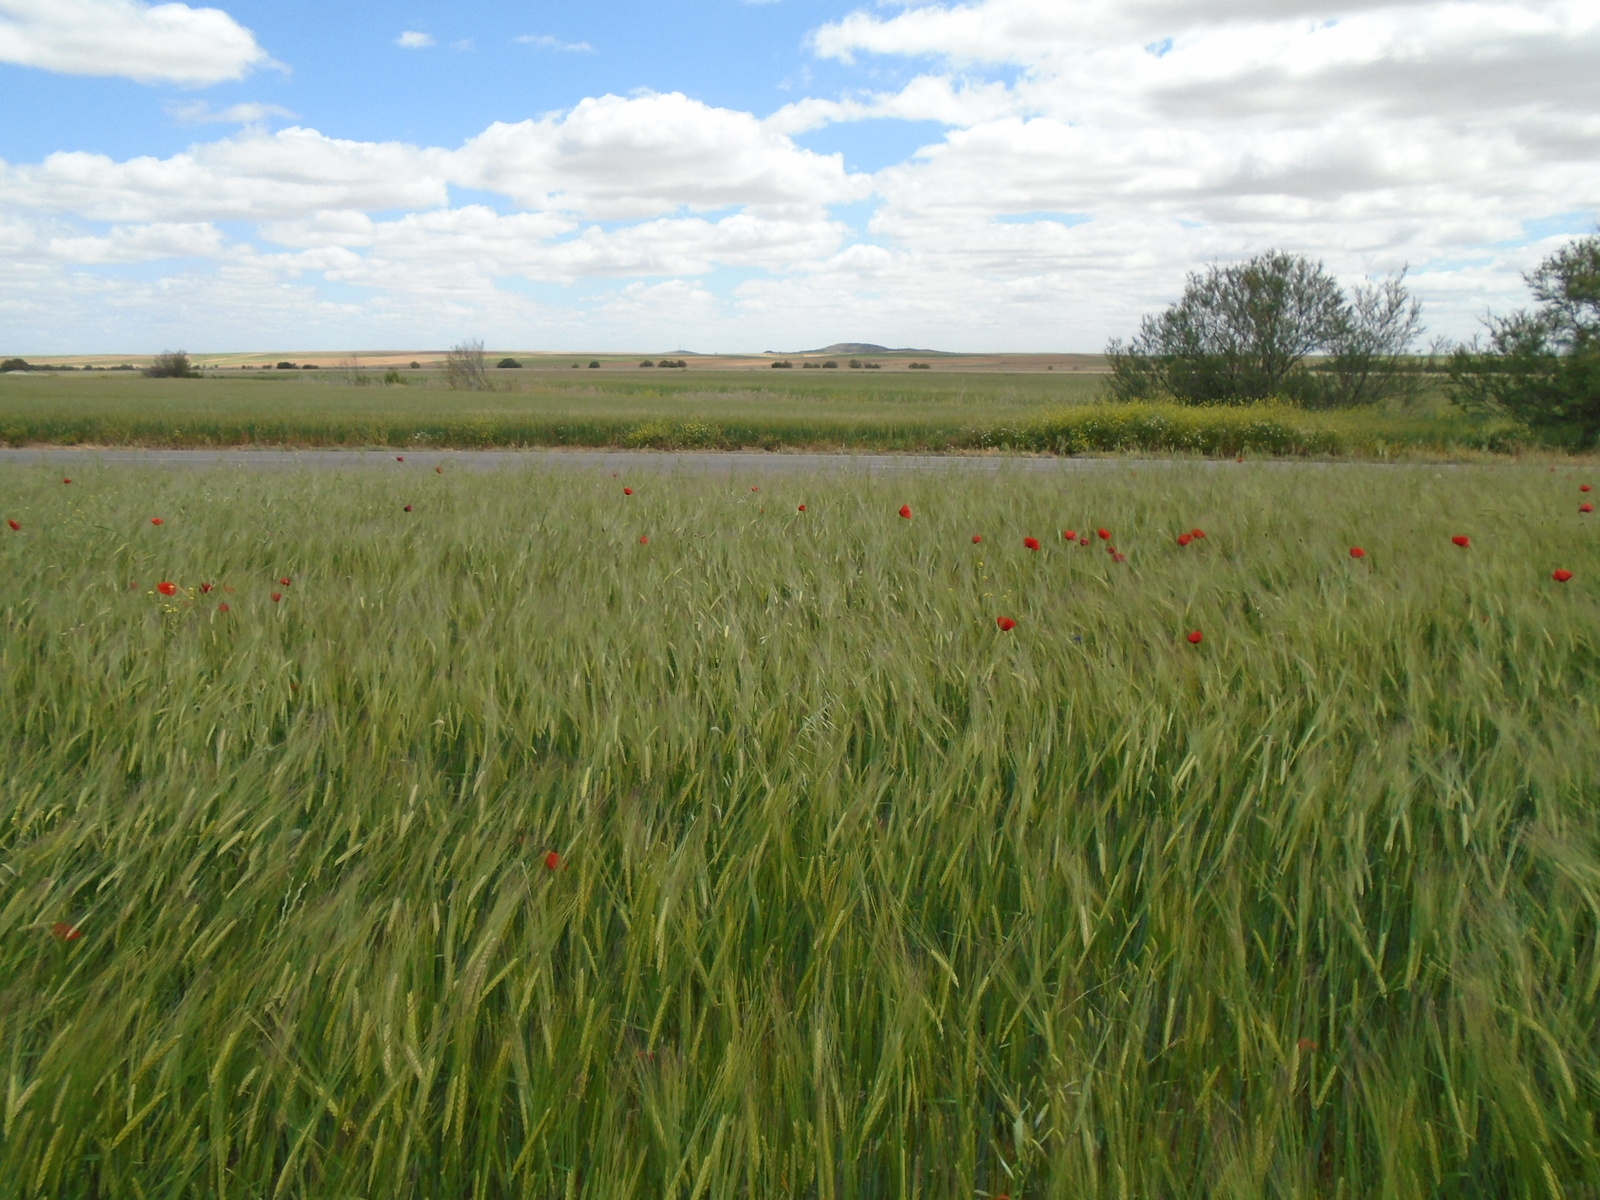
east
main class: Cropland
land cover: Barley
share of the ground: > 75 %
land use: Agriculture (excluding fallow land and kitchen gardens)
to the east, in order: Barley; Grass margins; Ditches and canals; Grass margins; Paved roads, cycling and walking lanes; Grass margins; Ditches and canals; Grass margins; Barley; Grass margins; Ditches and canals; Grass margins; Barley; Grass margins; Other bare soil
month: May
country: ES
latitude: 39.5884
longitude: -3.6135
